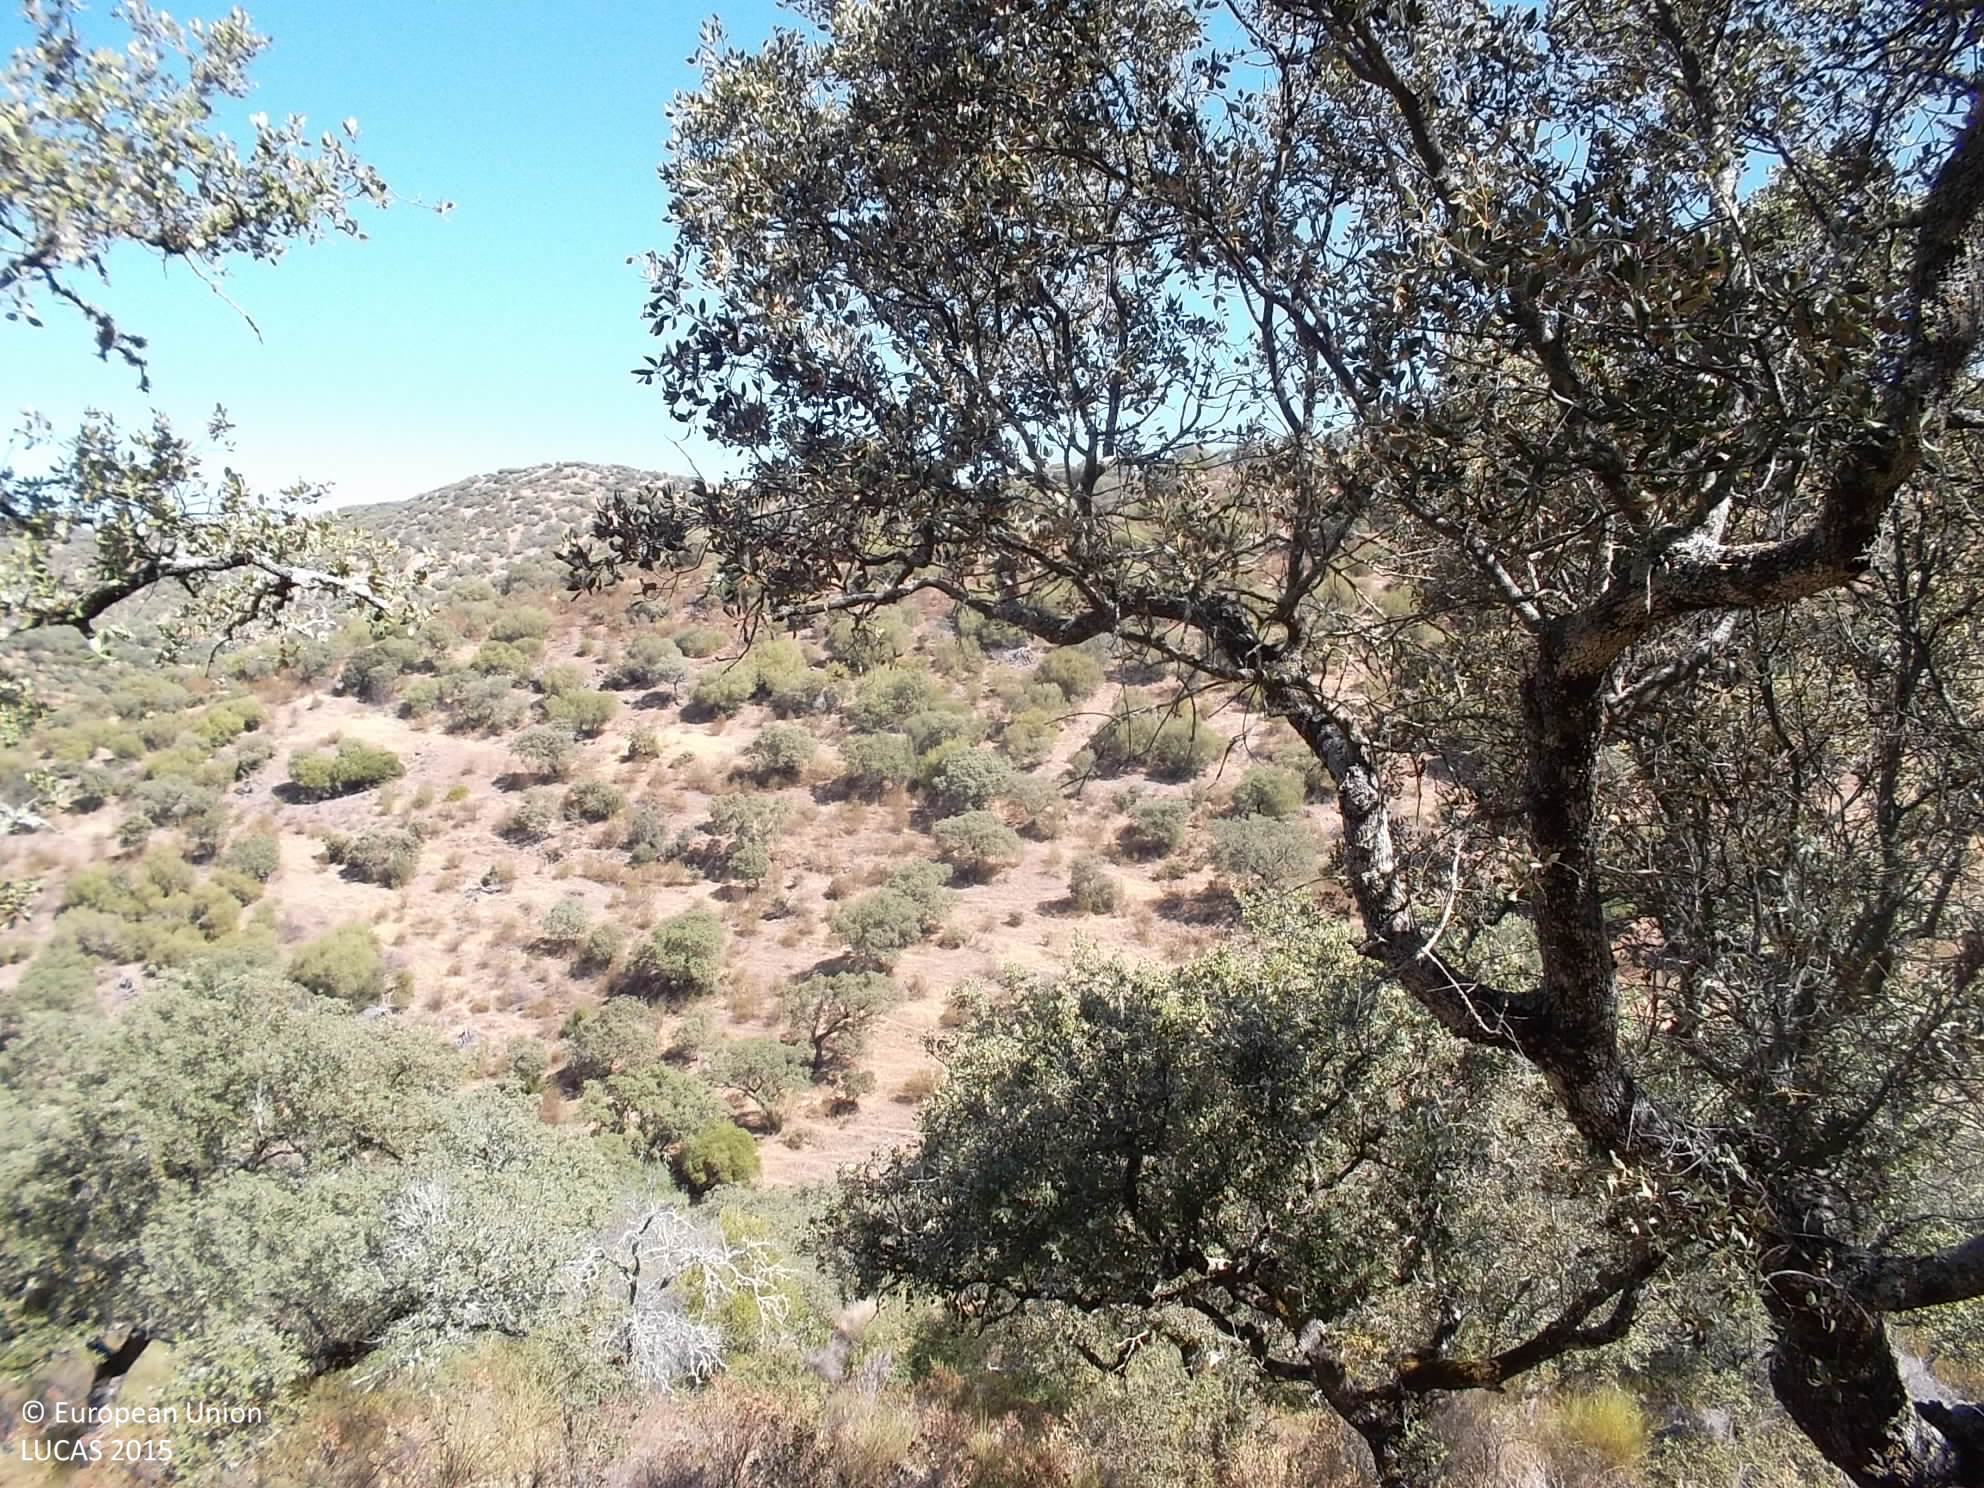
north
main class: Woodland
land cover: Broadleaved woodland
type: broadleaved evergreen forest
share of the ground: 25 - 50 %
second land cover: Shrubland without tree cover
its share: 25 - 50 %
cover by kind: broadleaved forest trees 40 %, shrubs 40 %, herbaceous plants 20 %
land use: Forestry
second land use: Agriculture (excluding fallow land and kitchen gardens)
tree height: < 5 m
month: August
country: ES
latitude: 38.5331
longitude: -6.6799
